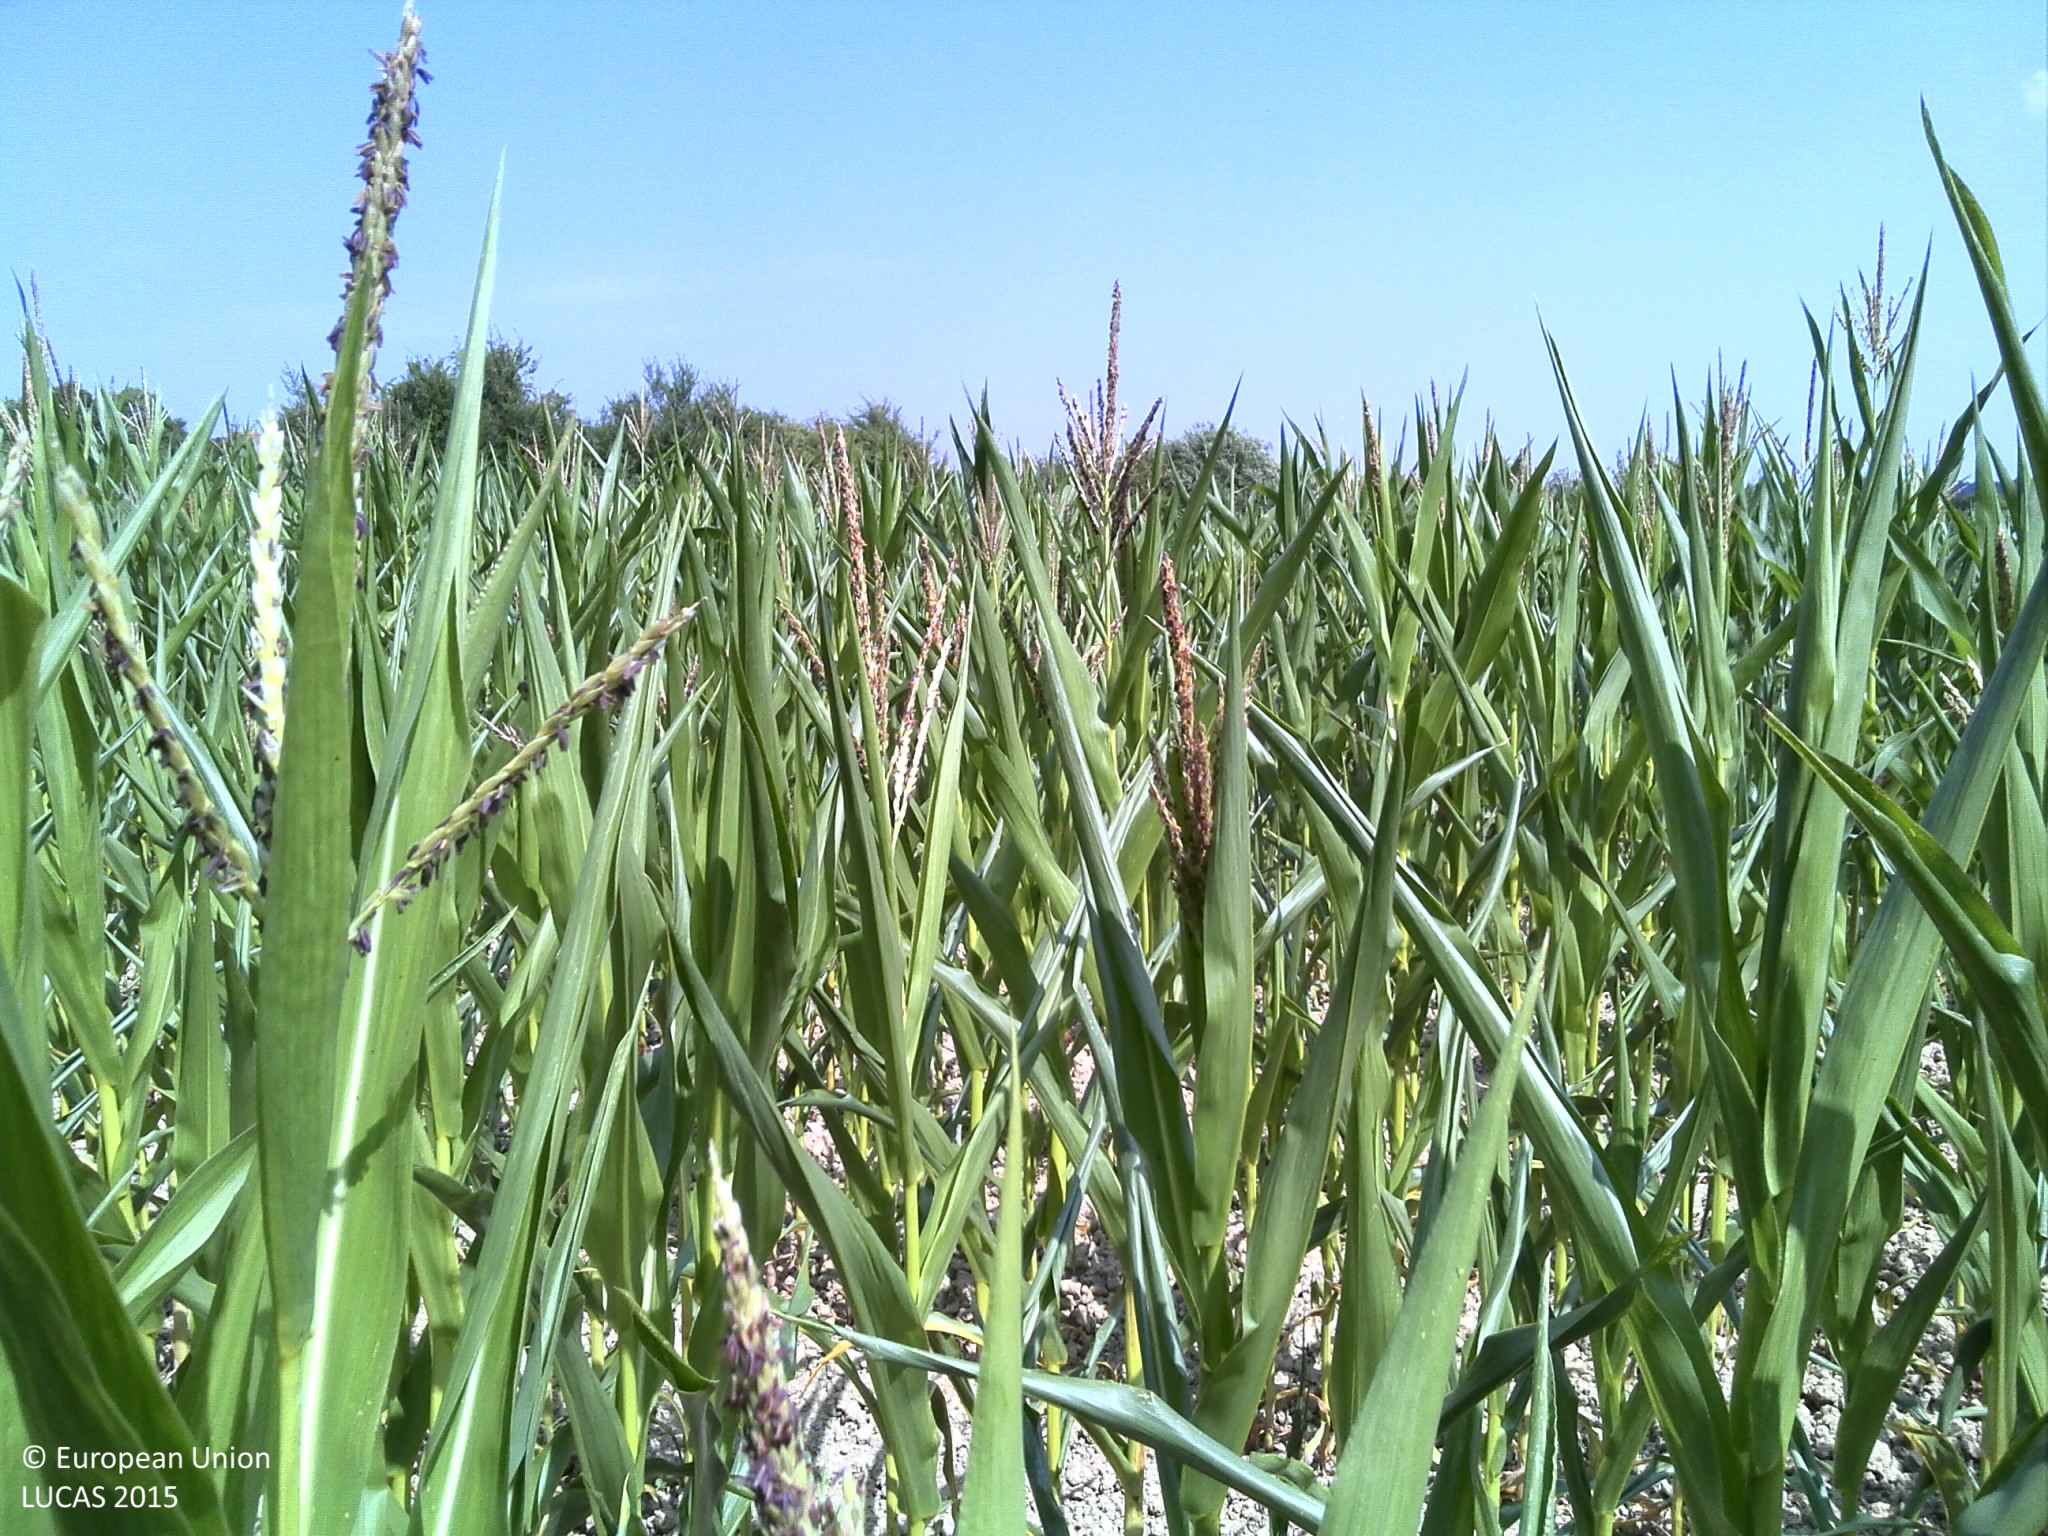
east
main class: Cropland
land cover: Maize
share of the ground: > 75 %
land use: Agriculture (excluding fallow land and kitchen gardens)
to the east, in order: Maize; Abandoned hedges; Fences; Grassland without tree/shrub cover
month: July
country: FR
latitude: 48.8608
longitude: 4.8589
